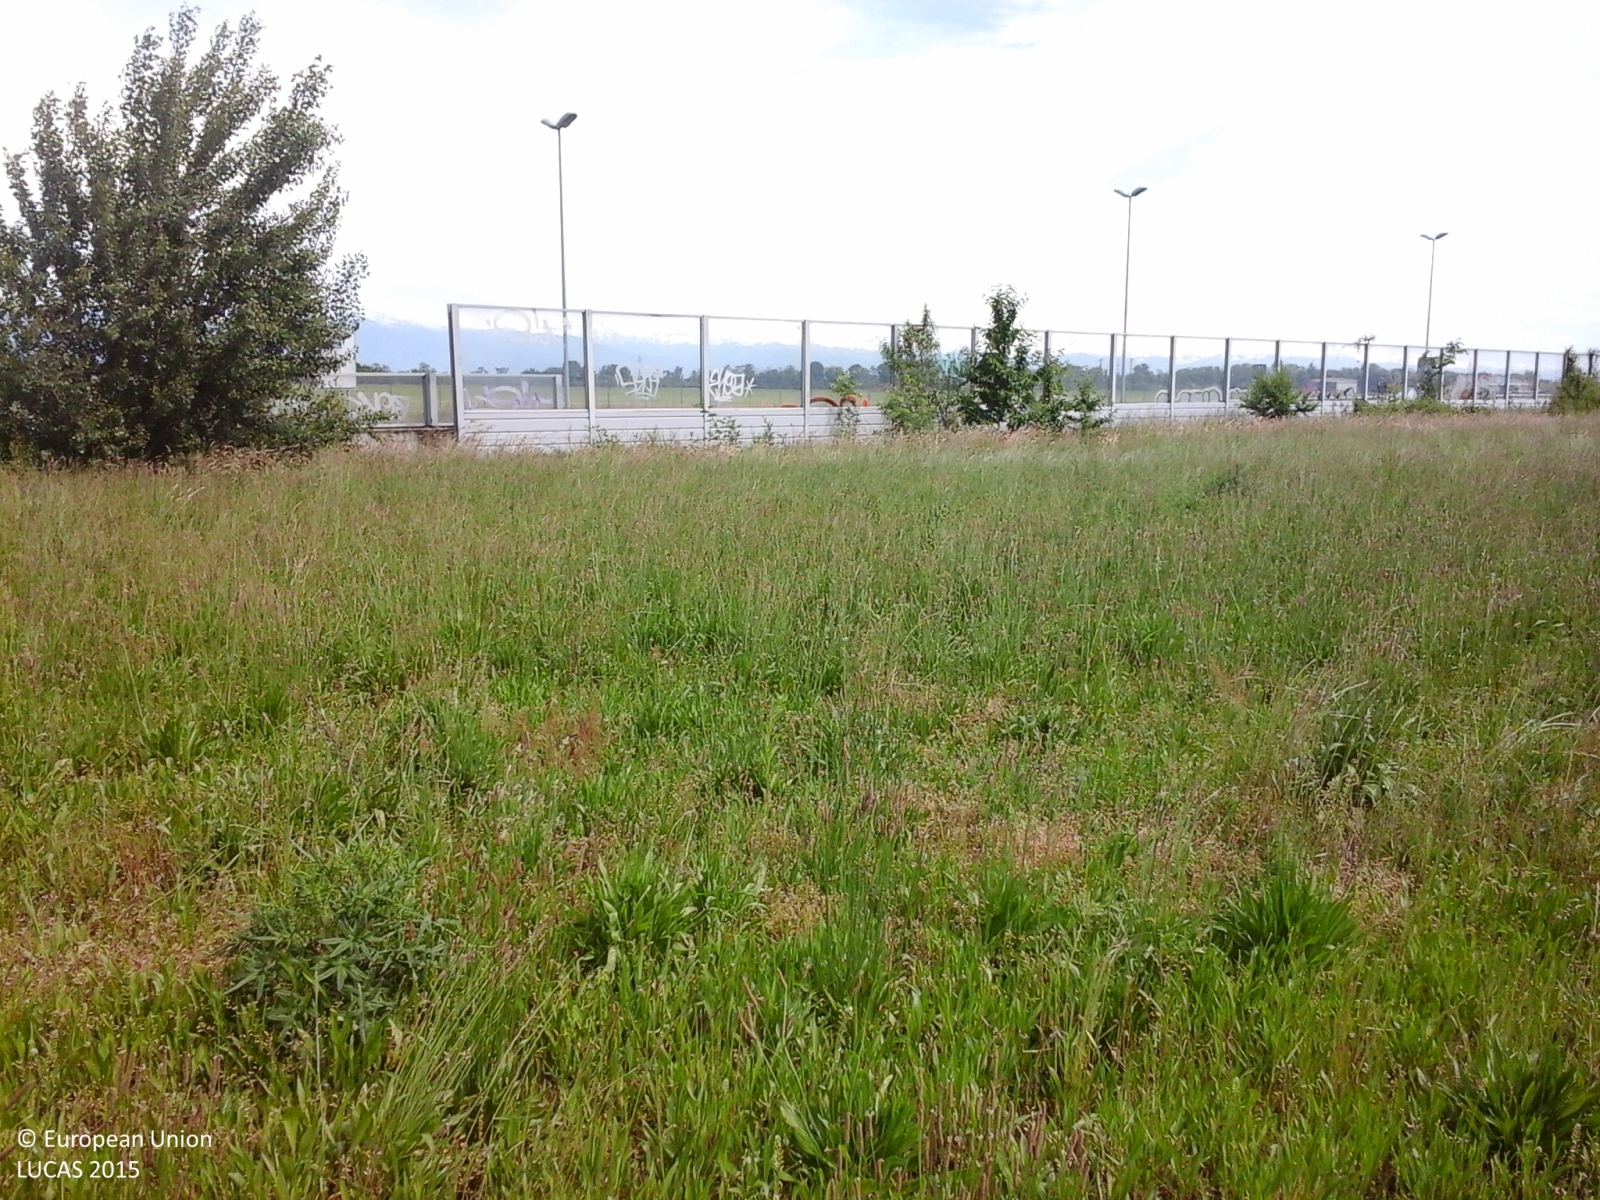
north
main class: Cropland
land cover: Temporary grasslands
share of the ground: > 75 %
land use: Agriculture (excluding fallow land and kitchen gardens)
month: May
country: IT
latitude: 45.0805
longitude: 7.6032
